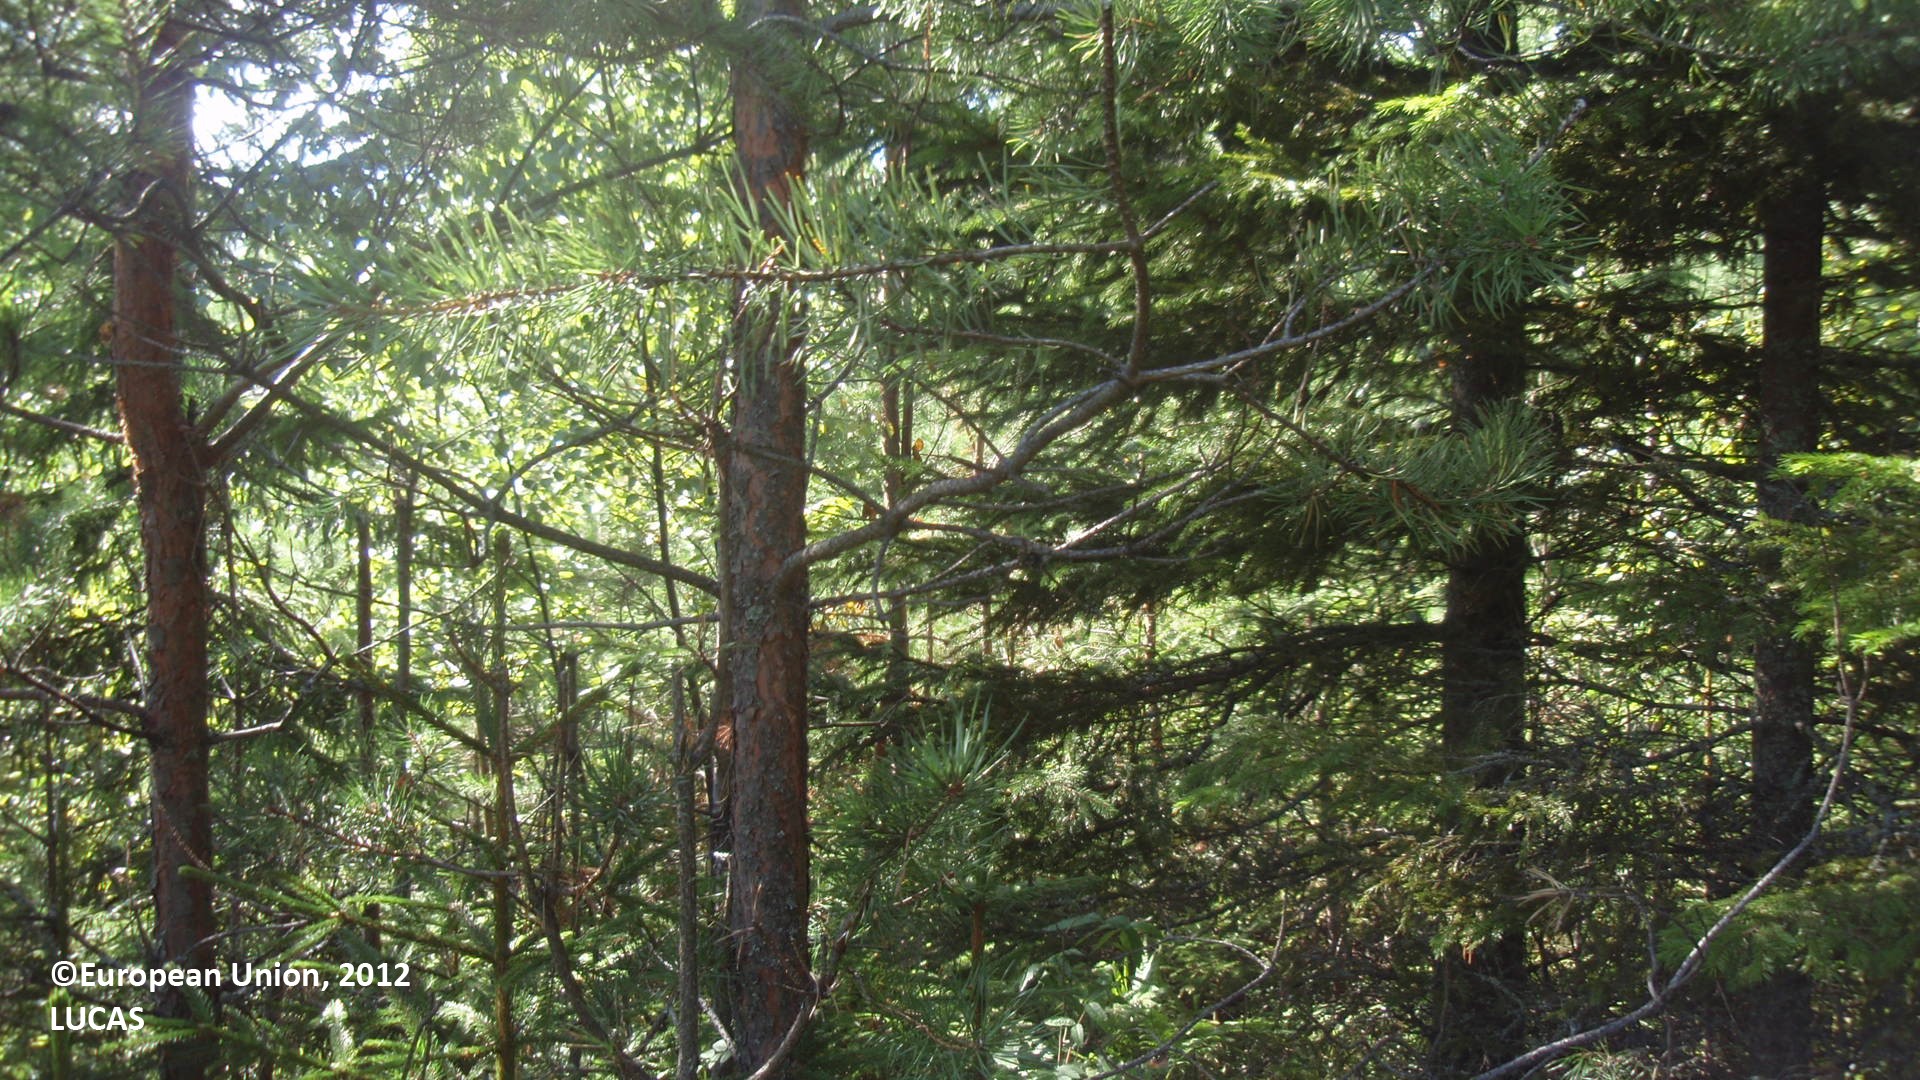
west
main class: Woodland
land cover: Pine dominated mixed woodland
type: boreal forest
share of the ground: 50 - 75 %
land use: Forestry
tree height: > 5 m
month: August
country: FI
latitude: 61.5058
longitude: 27.7547
